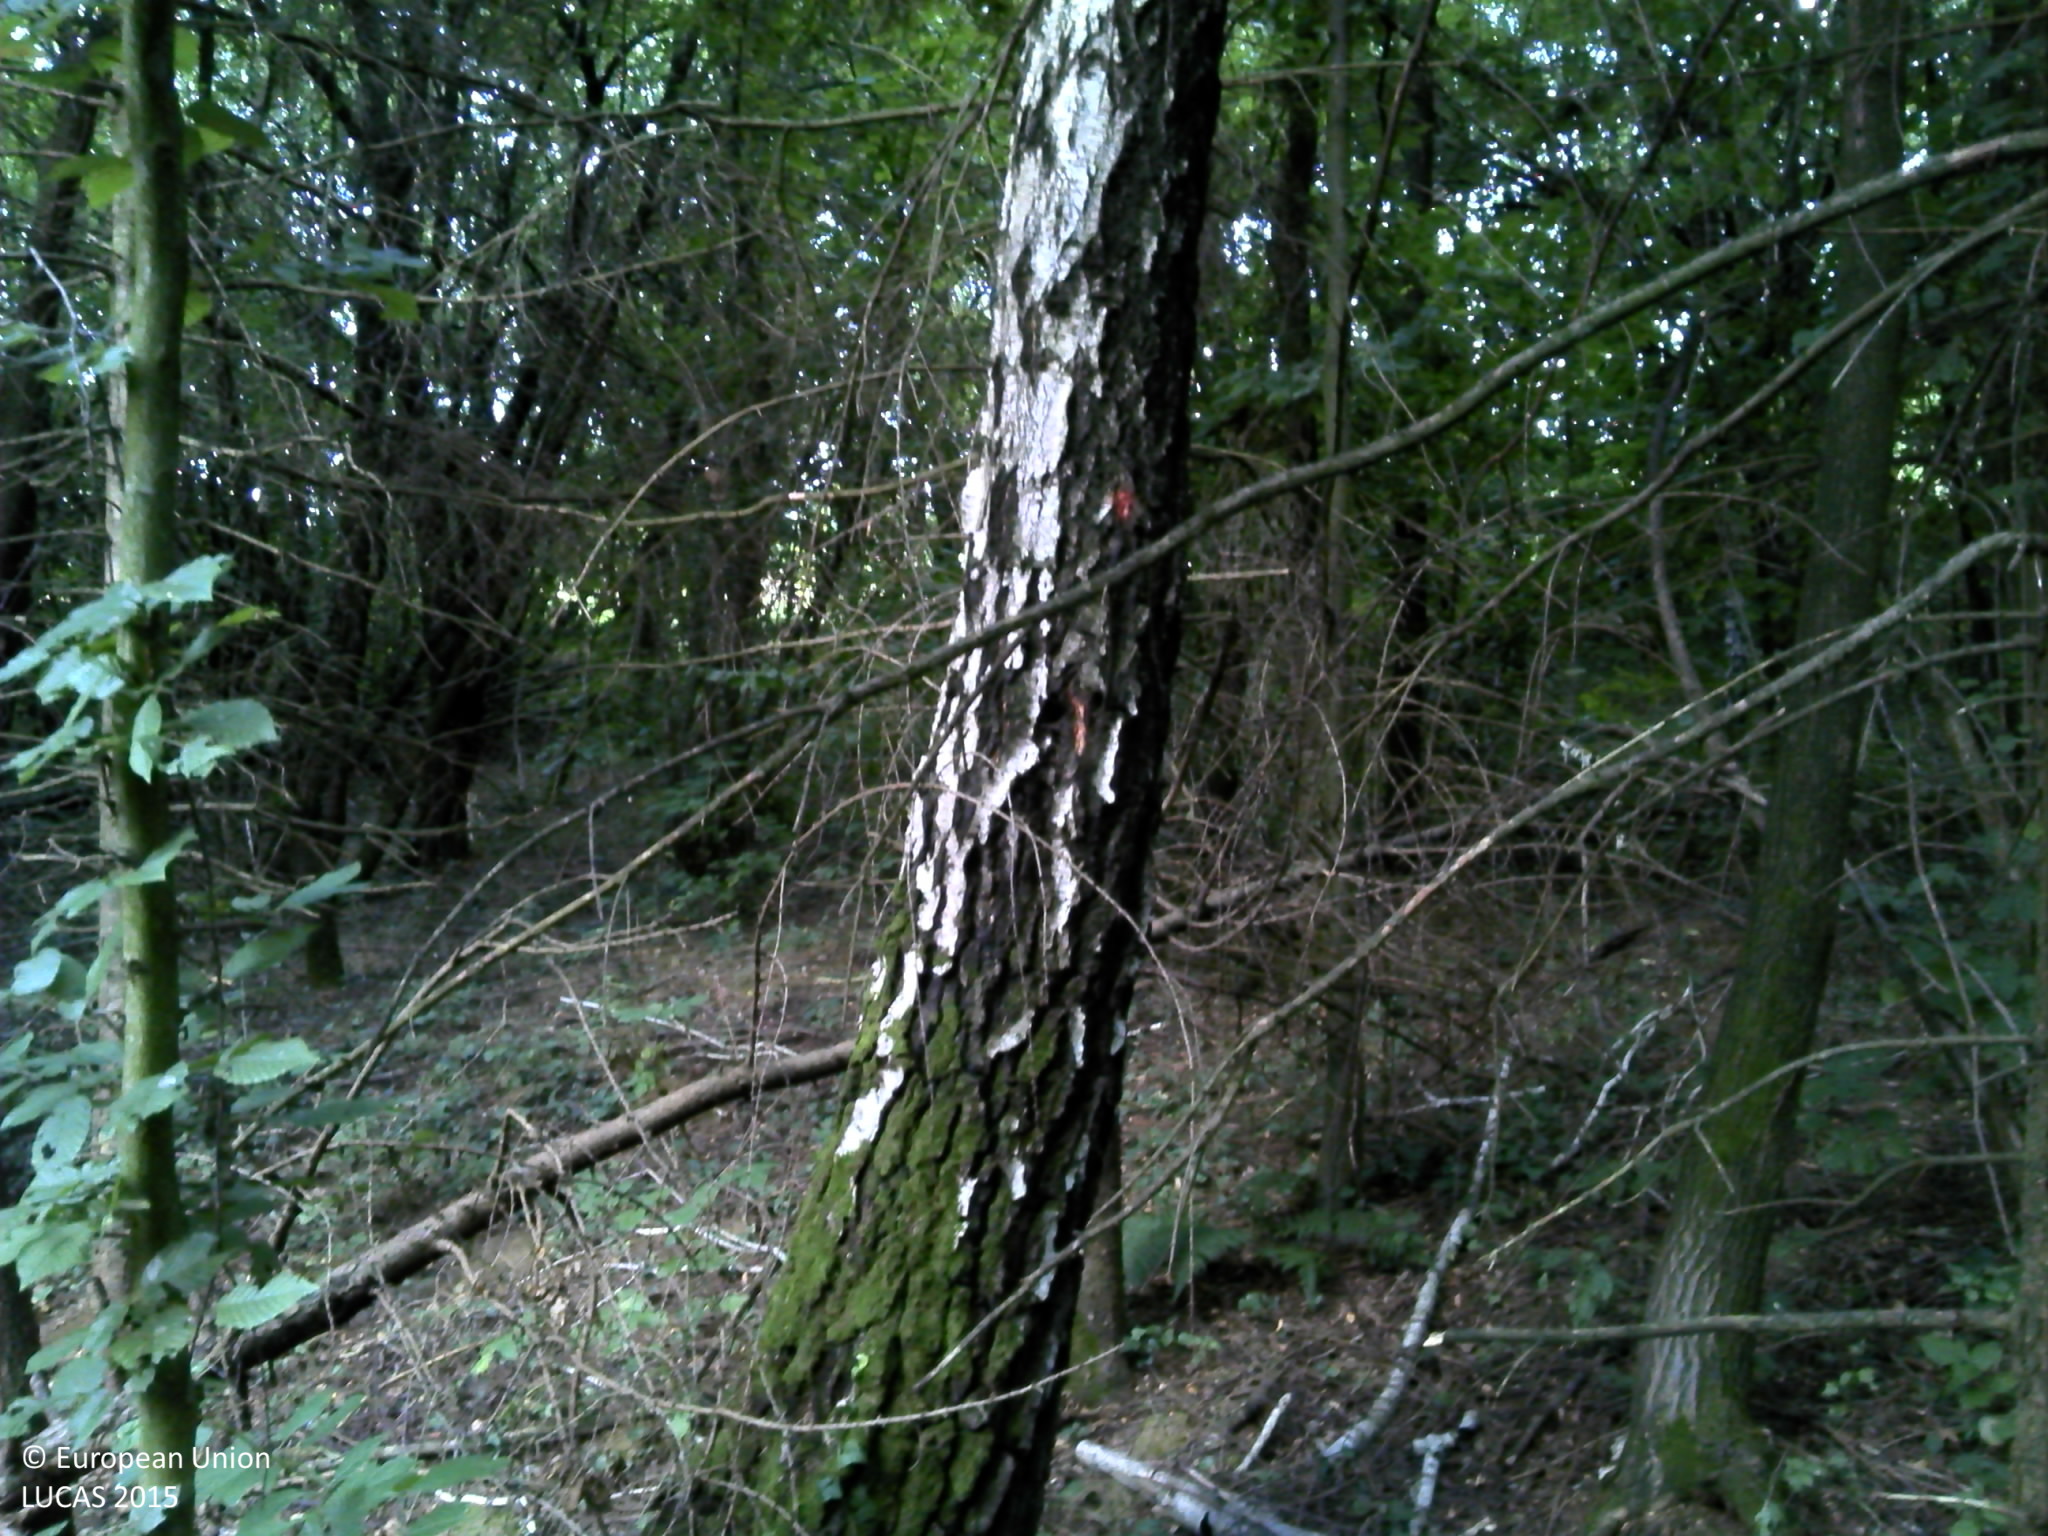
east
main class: Woodland
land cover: Spruce dominated mixed woodland
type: broadleaved evergreen forest
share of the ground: > 75 %
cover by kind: coniferous forest trees 60 %, broadleaved forest trees 20 %, lichens and mosses 20 %
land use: Forestry
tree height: > 5 m
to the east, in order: Spruce dominated mixed woodland; Grassland without tree/shrub cover; Tracks; Spruce dominated mixed woodland
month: July
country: HR
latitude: 45.5806
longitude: 16.7018
